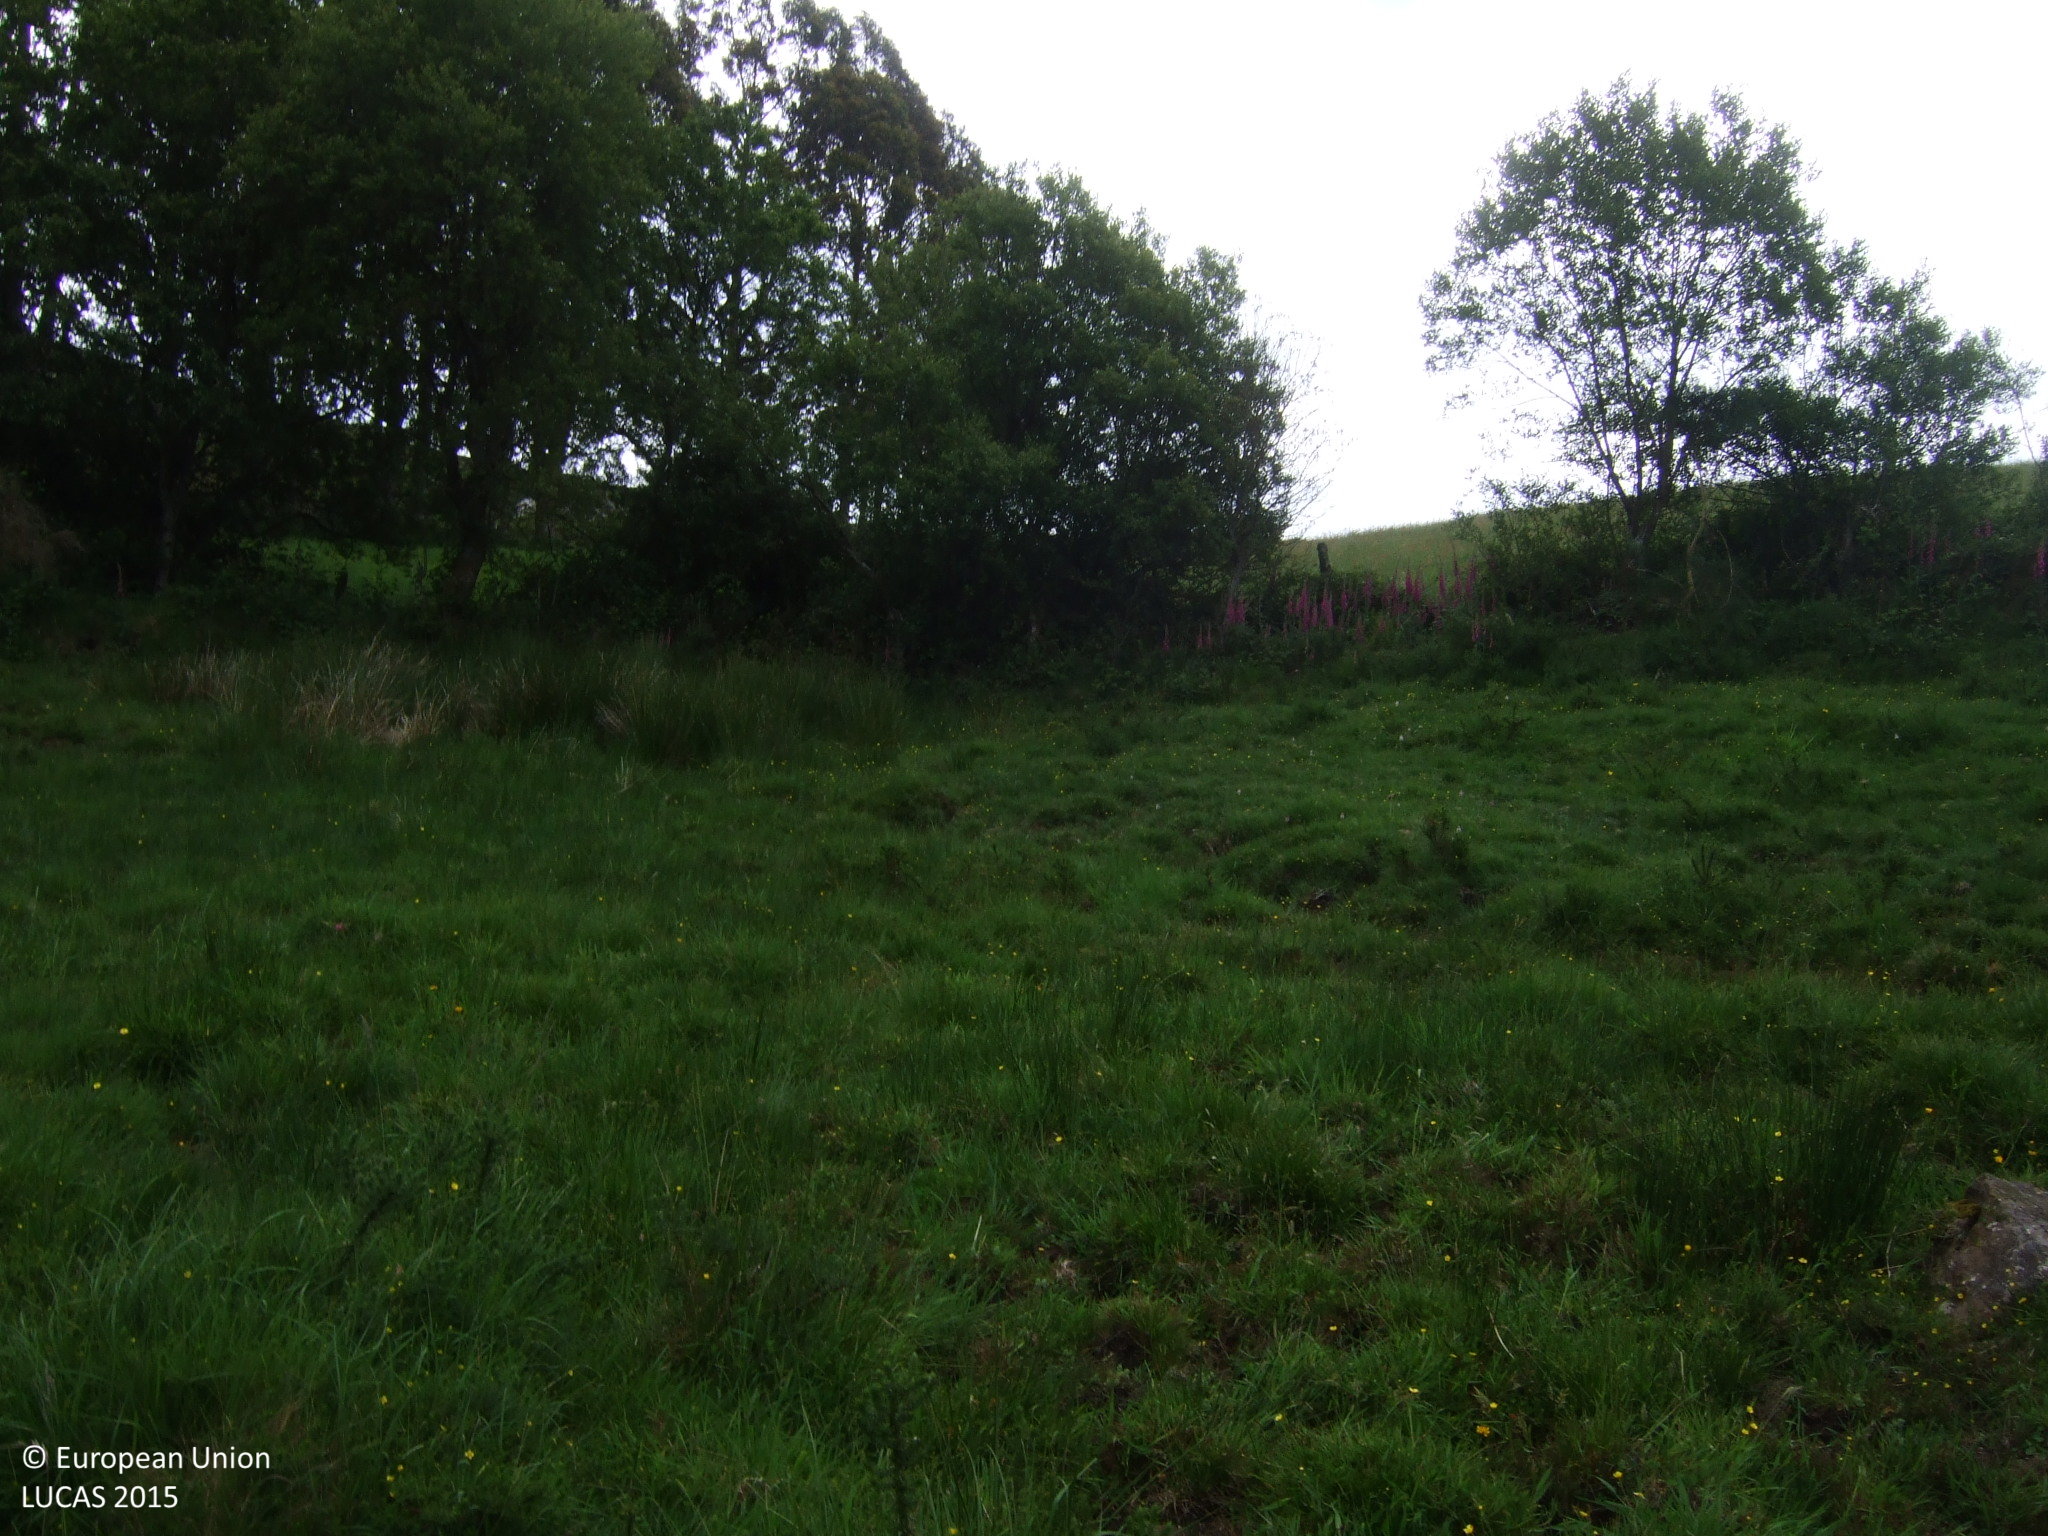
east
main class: Grassland
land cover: Grassland without tree/shrub cover
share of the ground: > 75 %
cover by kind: herbaceous plants 100 %
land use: Agriculture (excluding fallow land and kitchen gardens)
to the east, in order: Grassland without tree/shrub cover; Abandoned hedges; Fences; Grassland without tree/shrub cover; Shrubland without tree cover; Electric lines; Grassland without tree/shrub cover; Shruby margins; Grassland without tree/shrub cover; Fences; Paved roads, cycling and walking lanes; Shrubland without tree cover
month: June
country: ES
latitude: 43.4364
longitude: -7.5134
